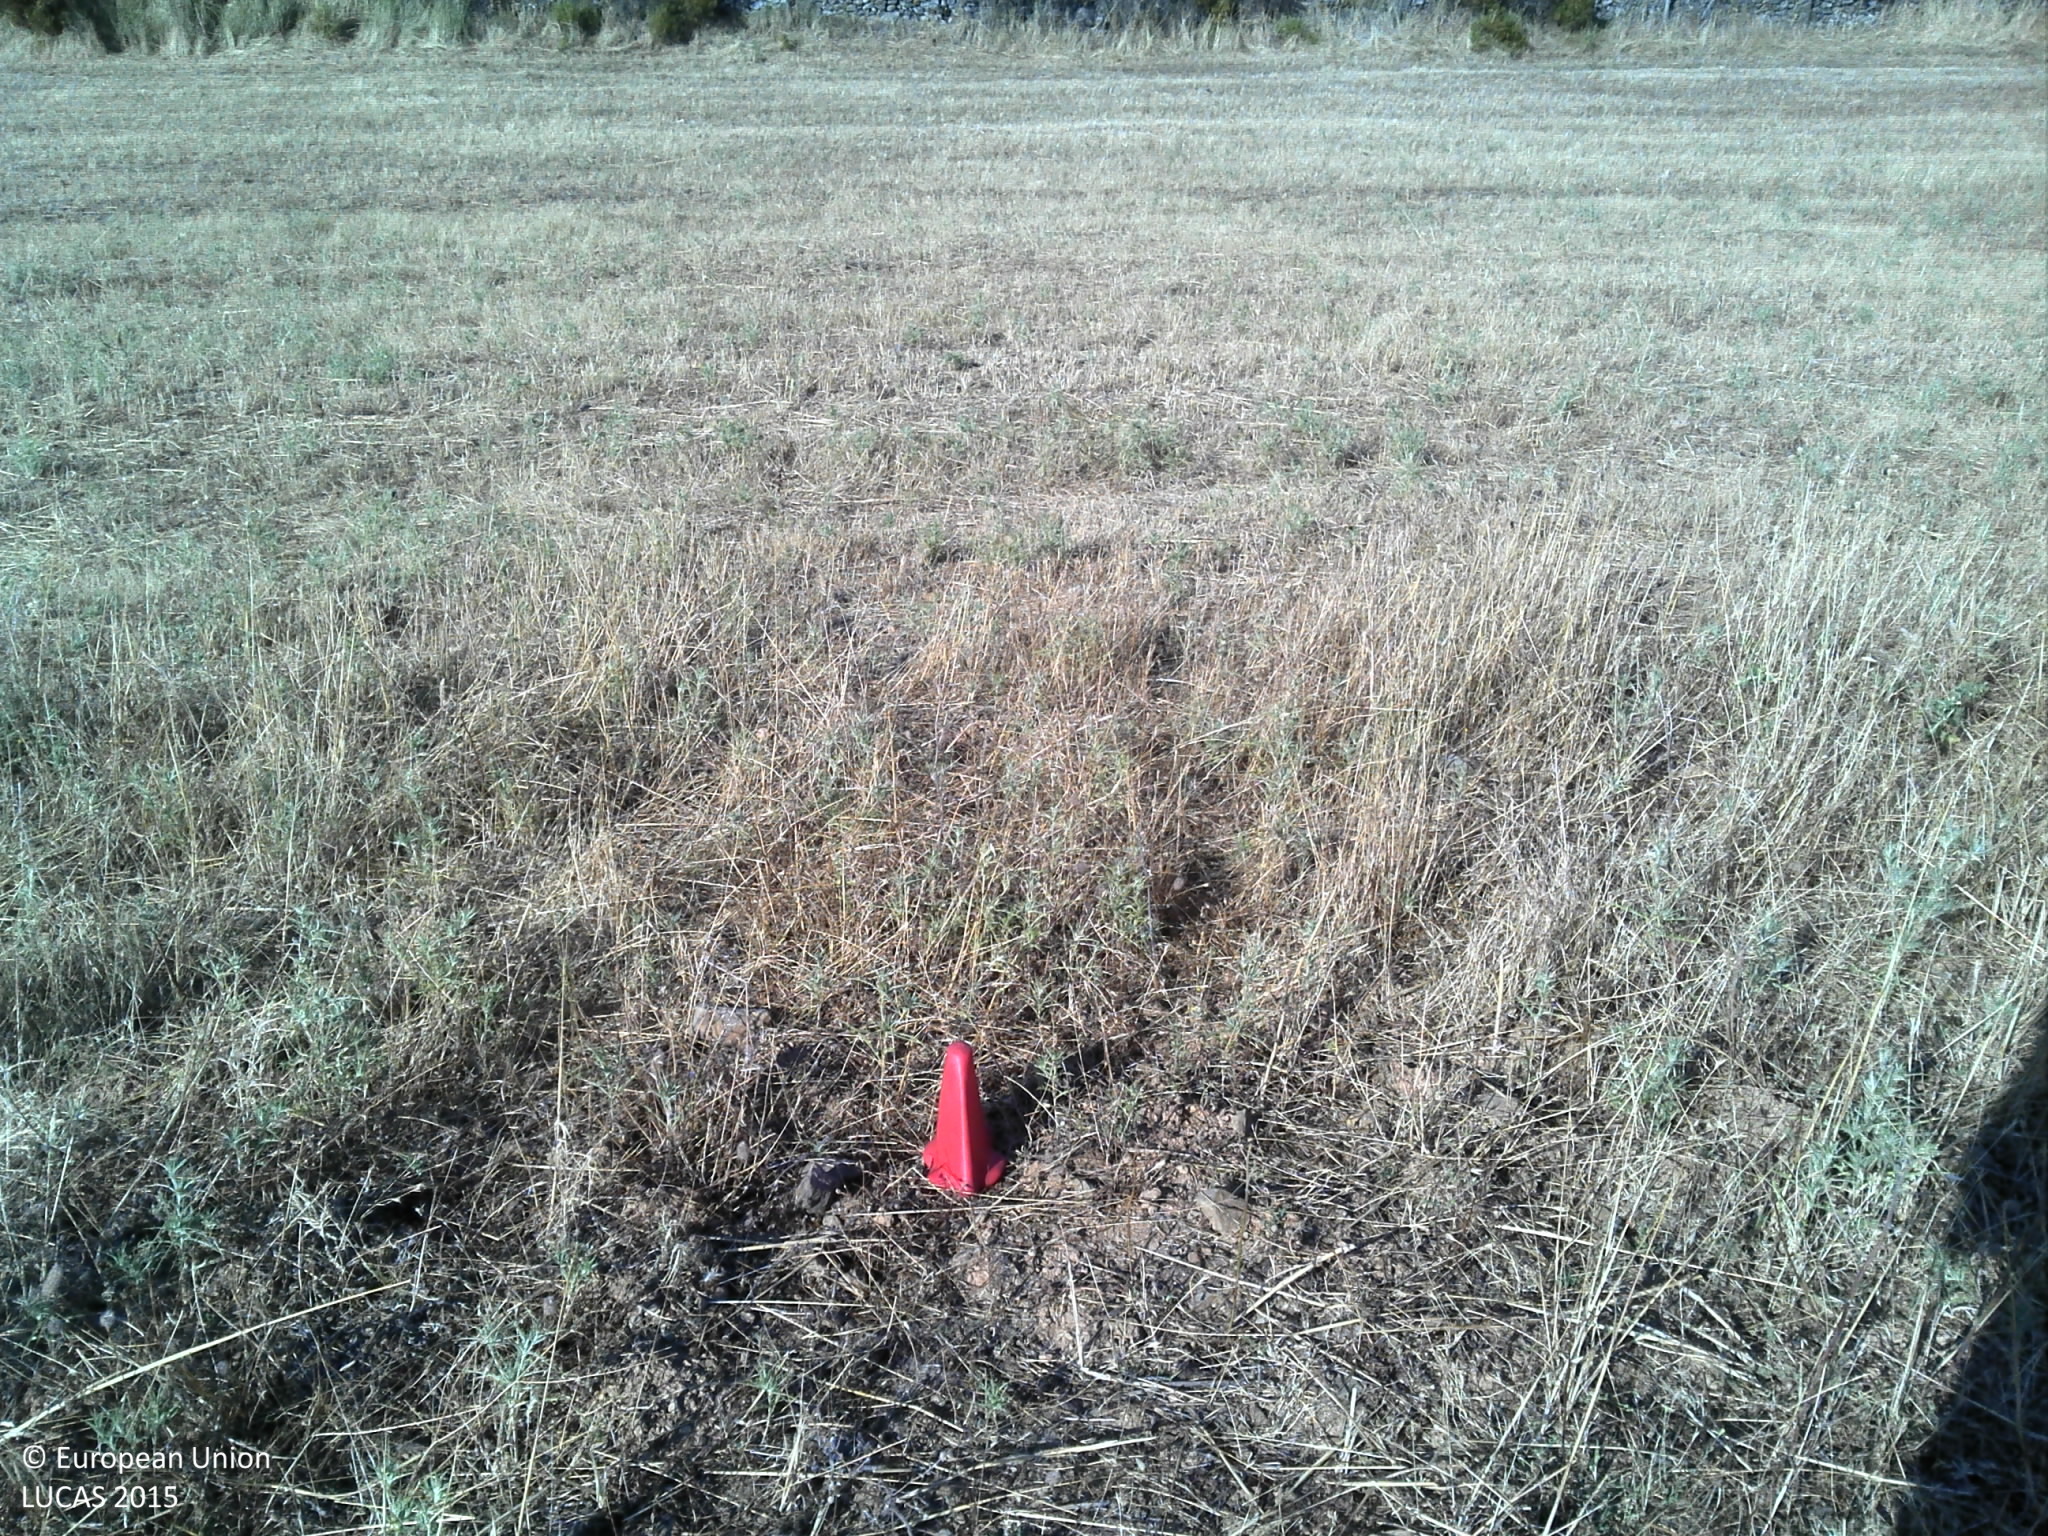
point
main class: Grassland
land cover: Grassland without tree/shrub cover
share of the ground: > 75 %
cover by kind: herbaceous plants 100 %
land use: Agriculture (excluding fallow land and kitchen gardens)
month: June
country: PT
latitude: 37.4611
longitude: -7.8913
